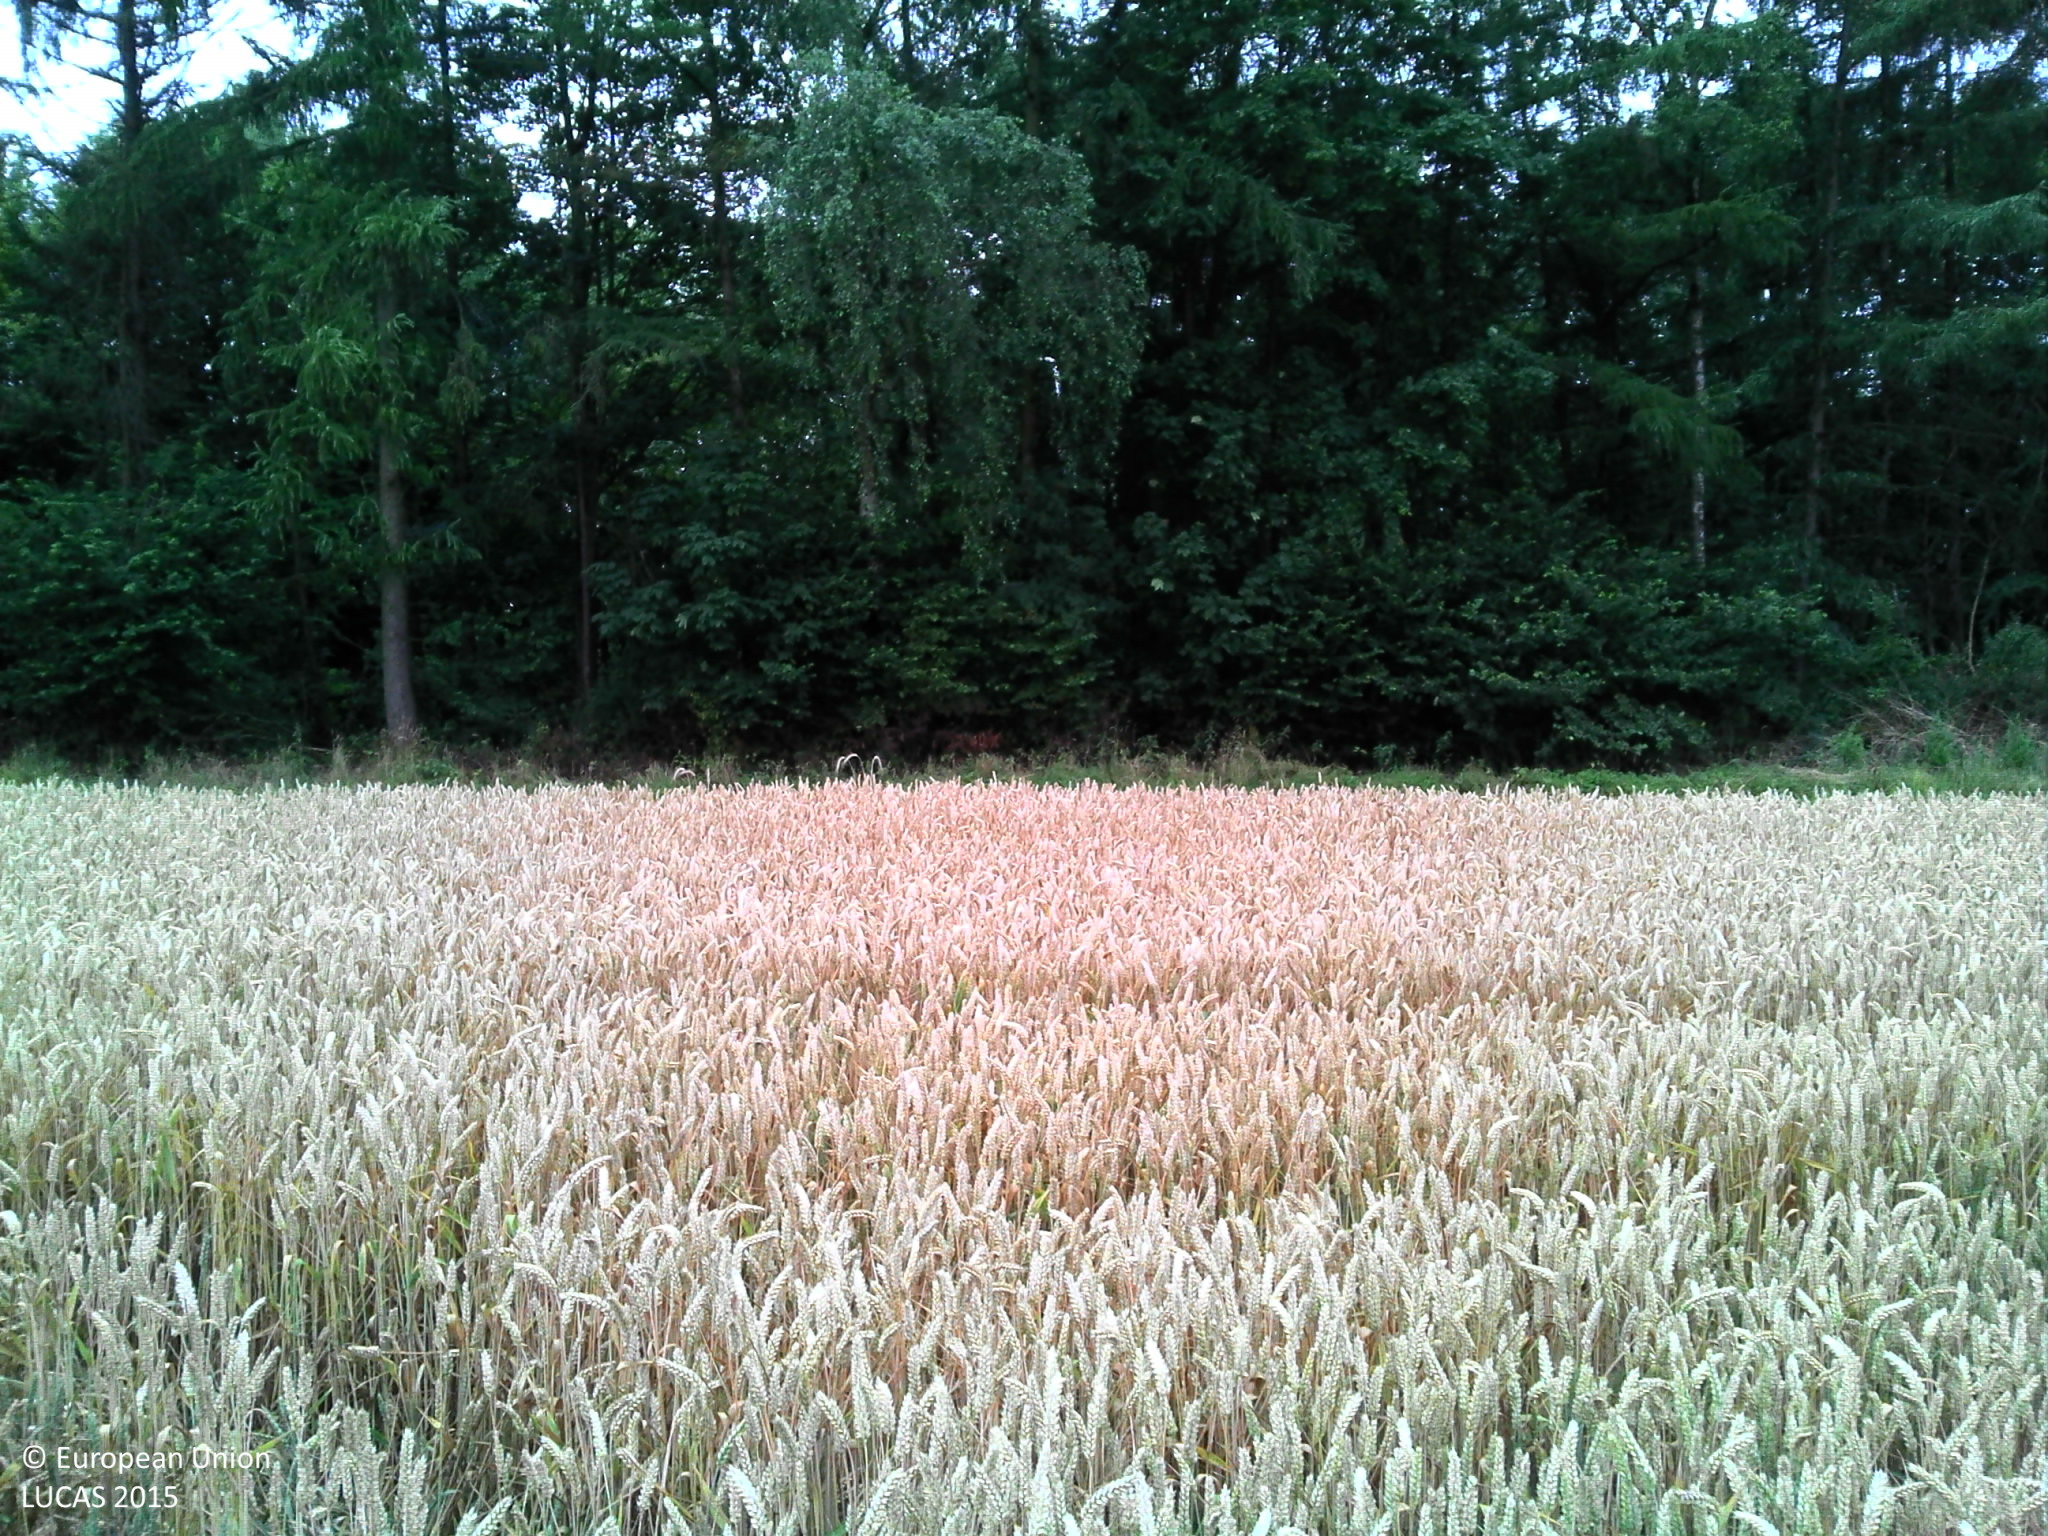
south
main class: Cropland
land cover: Common wheat
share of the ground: > 75 %
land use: Agriculture (excluding fallow land and kitchen gardens)
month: July
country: BE
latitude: 50.5039
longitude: 4.1717
